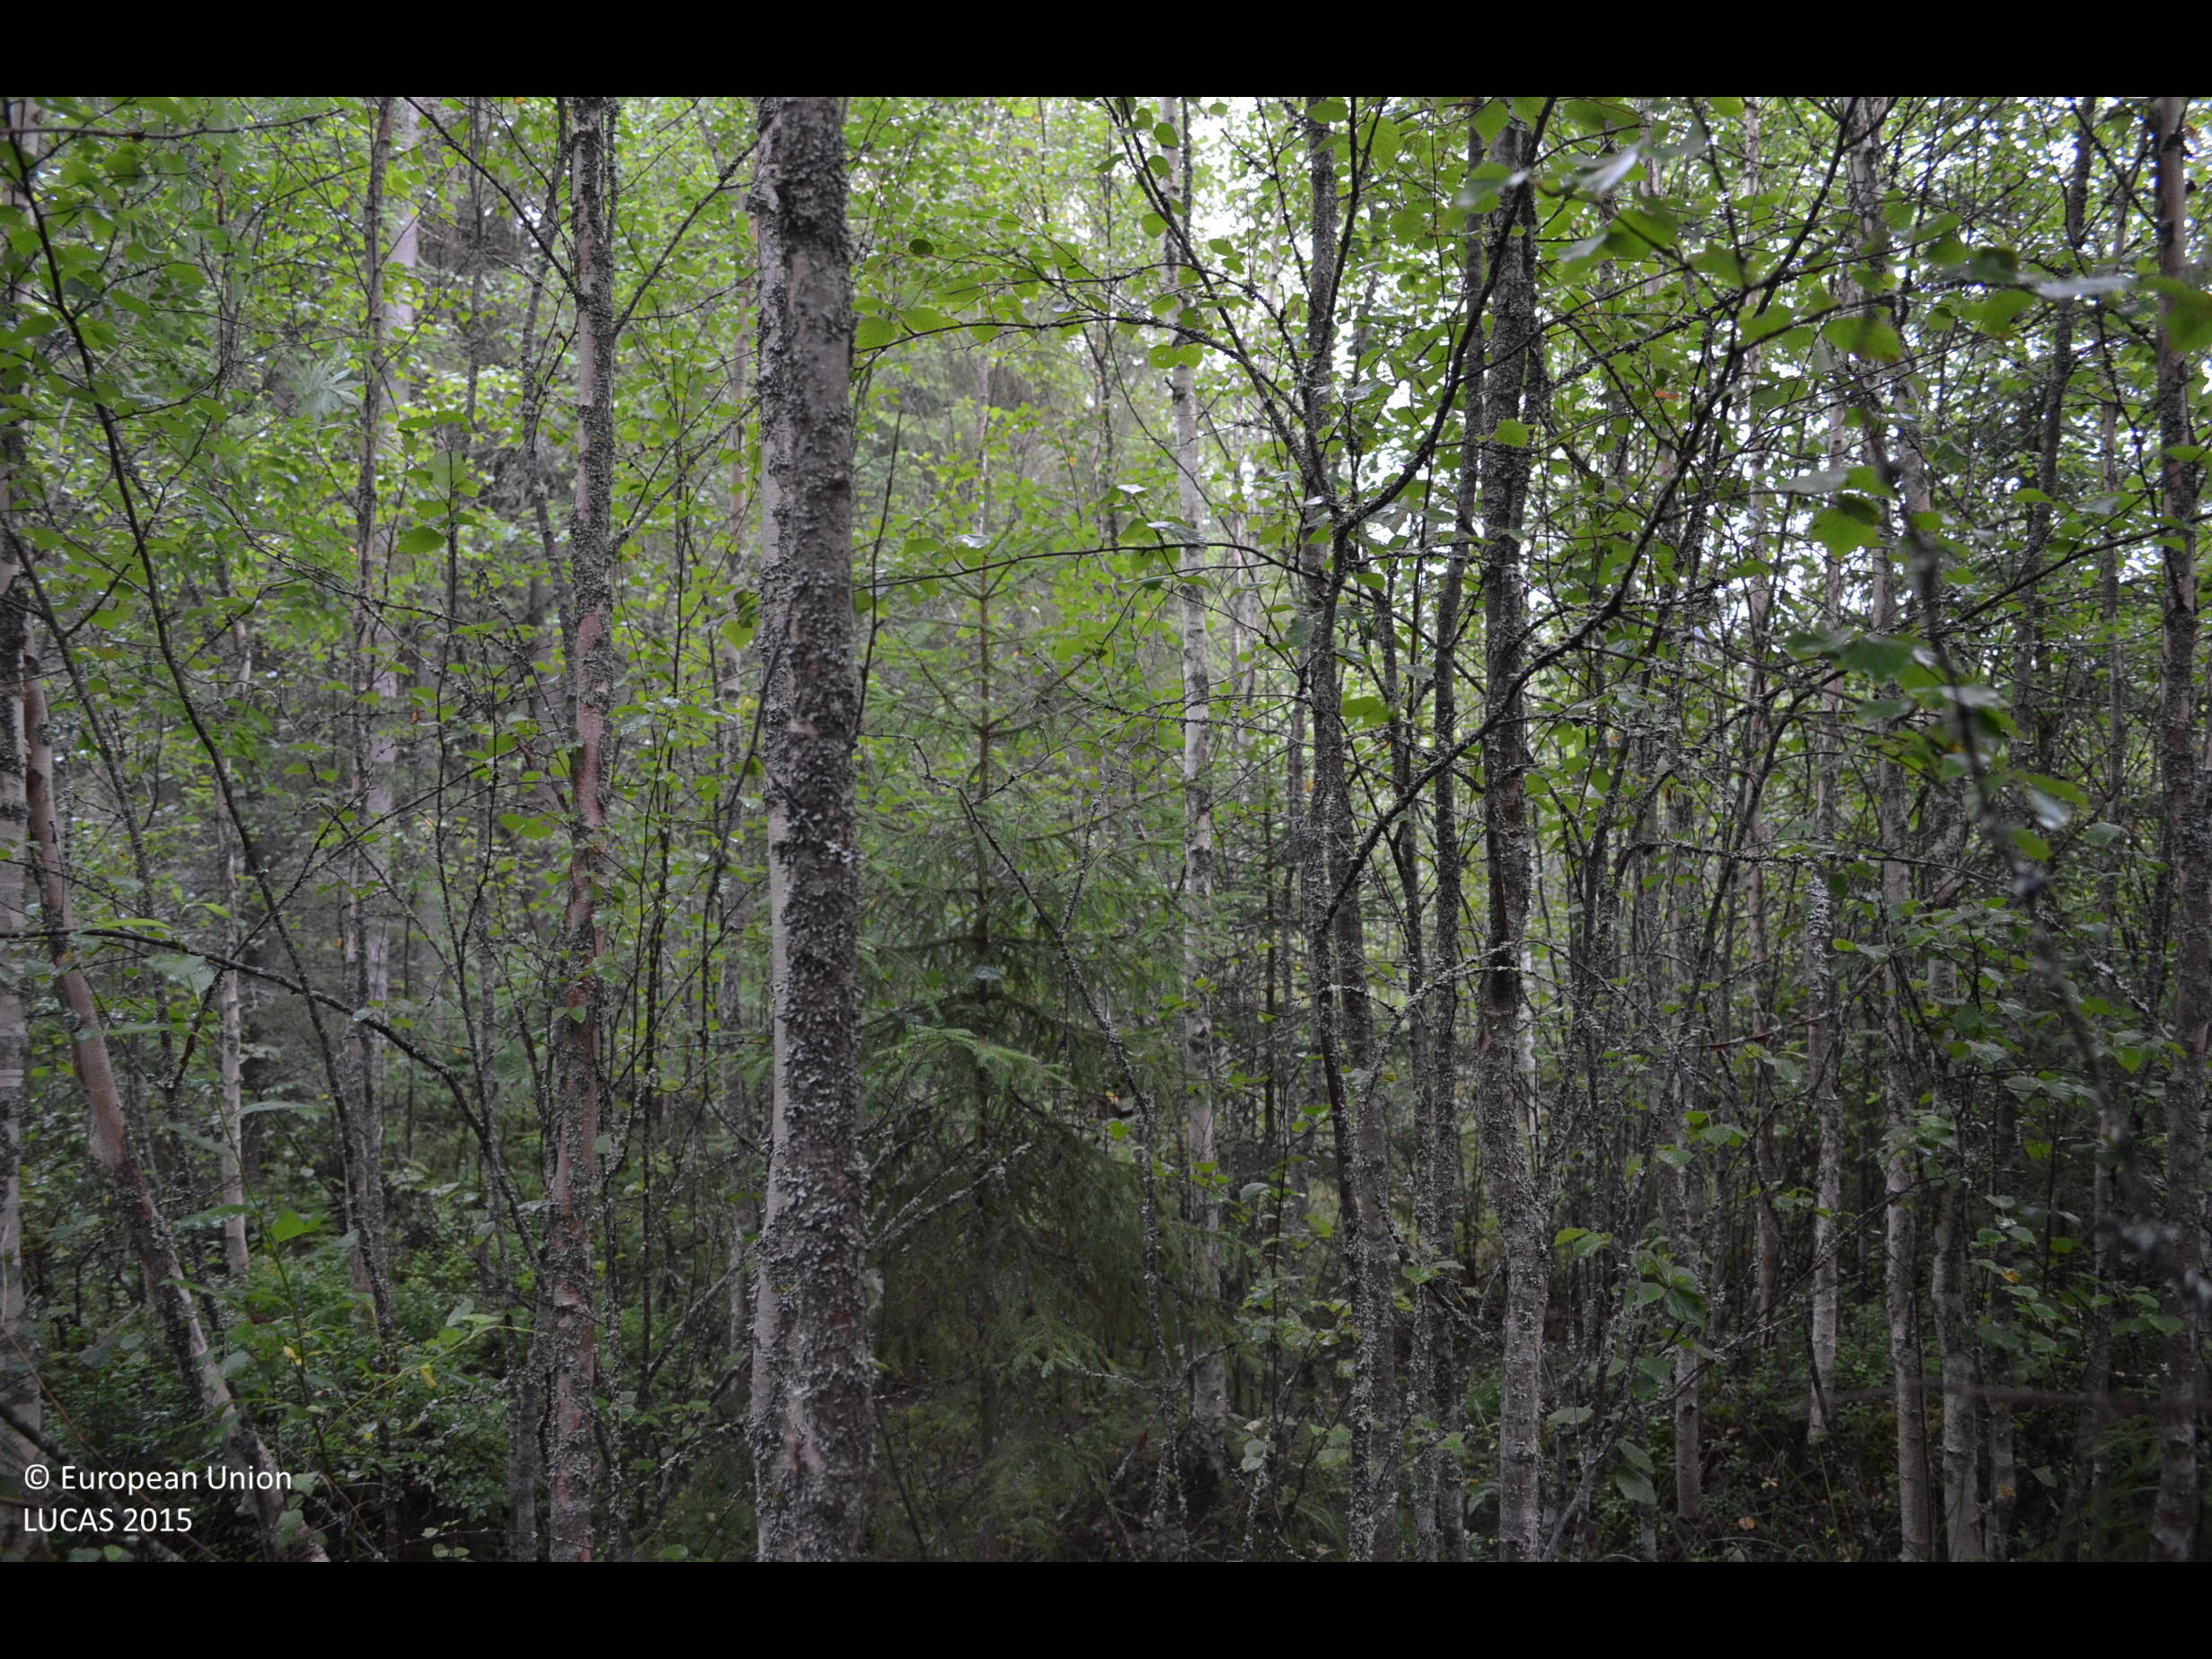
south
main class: Woodland
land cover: Broadleaved woodland
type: boreal forest
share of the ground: > 75 %
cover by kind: broadleaved forest trees 75 %, coniferous forest trees 20 %, herbaceous plants 5 %
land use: Forestry
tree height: > 5 m
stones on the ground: < 10 %
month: July
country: FI
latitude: 61.8988
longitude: 24.1907
